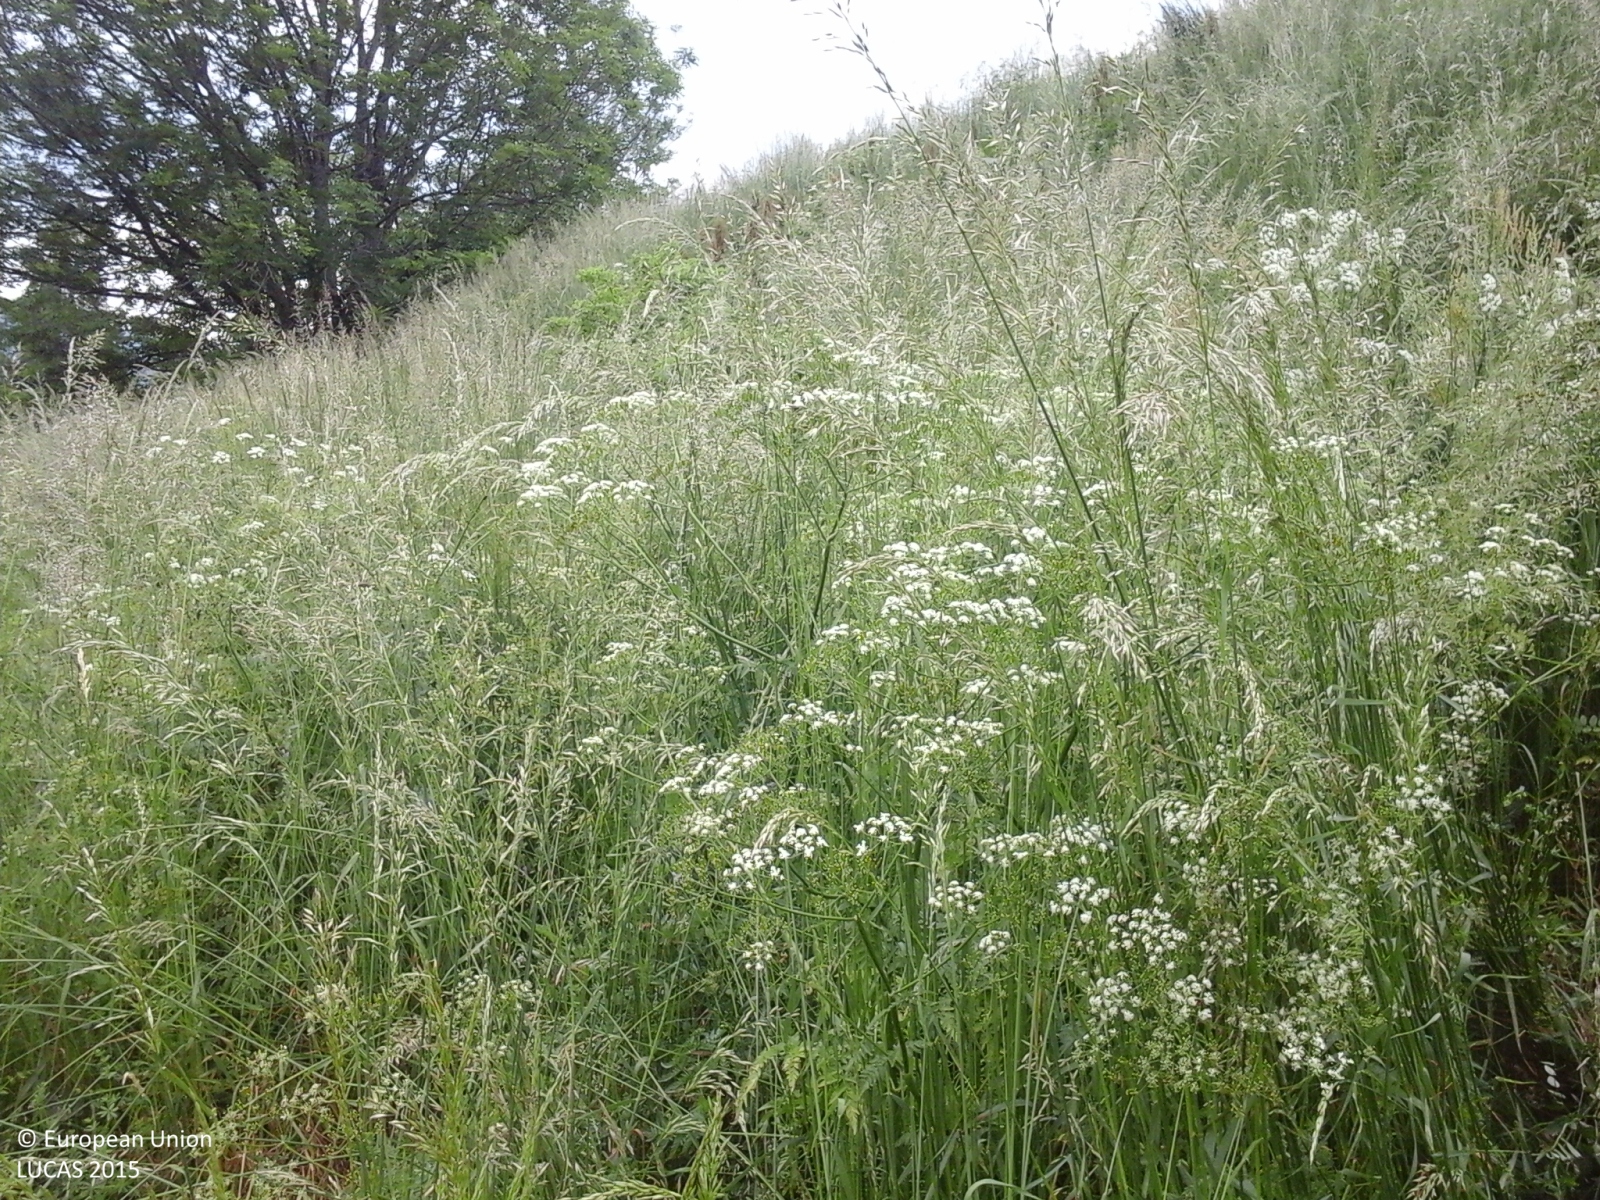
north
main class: Grassland
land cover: Grassland without tree/shrub cover
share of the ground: > 75 %
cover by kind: herbaceous plants 100 %
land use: Agriculture (excluding fallow land and kitchen gardens)
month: June
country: IT
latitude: 46.5733
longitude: 12.5417
